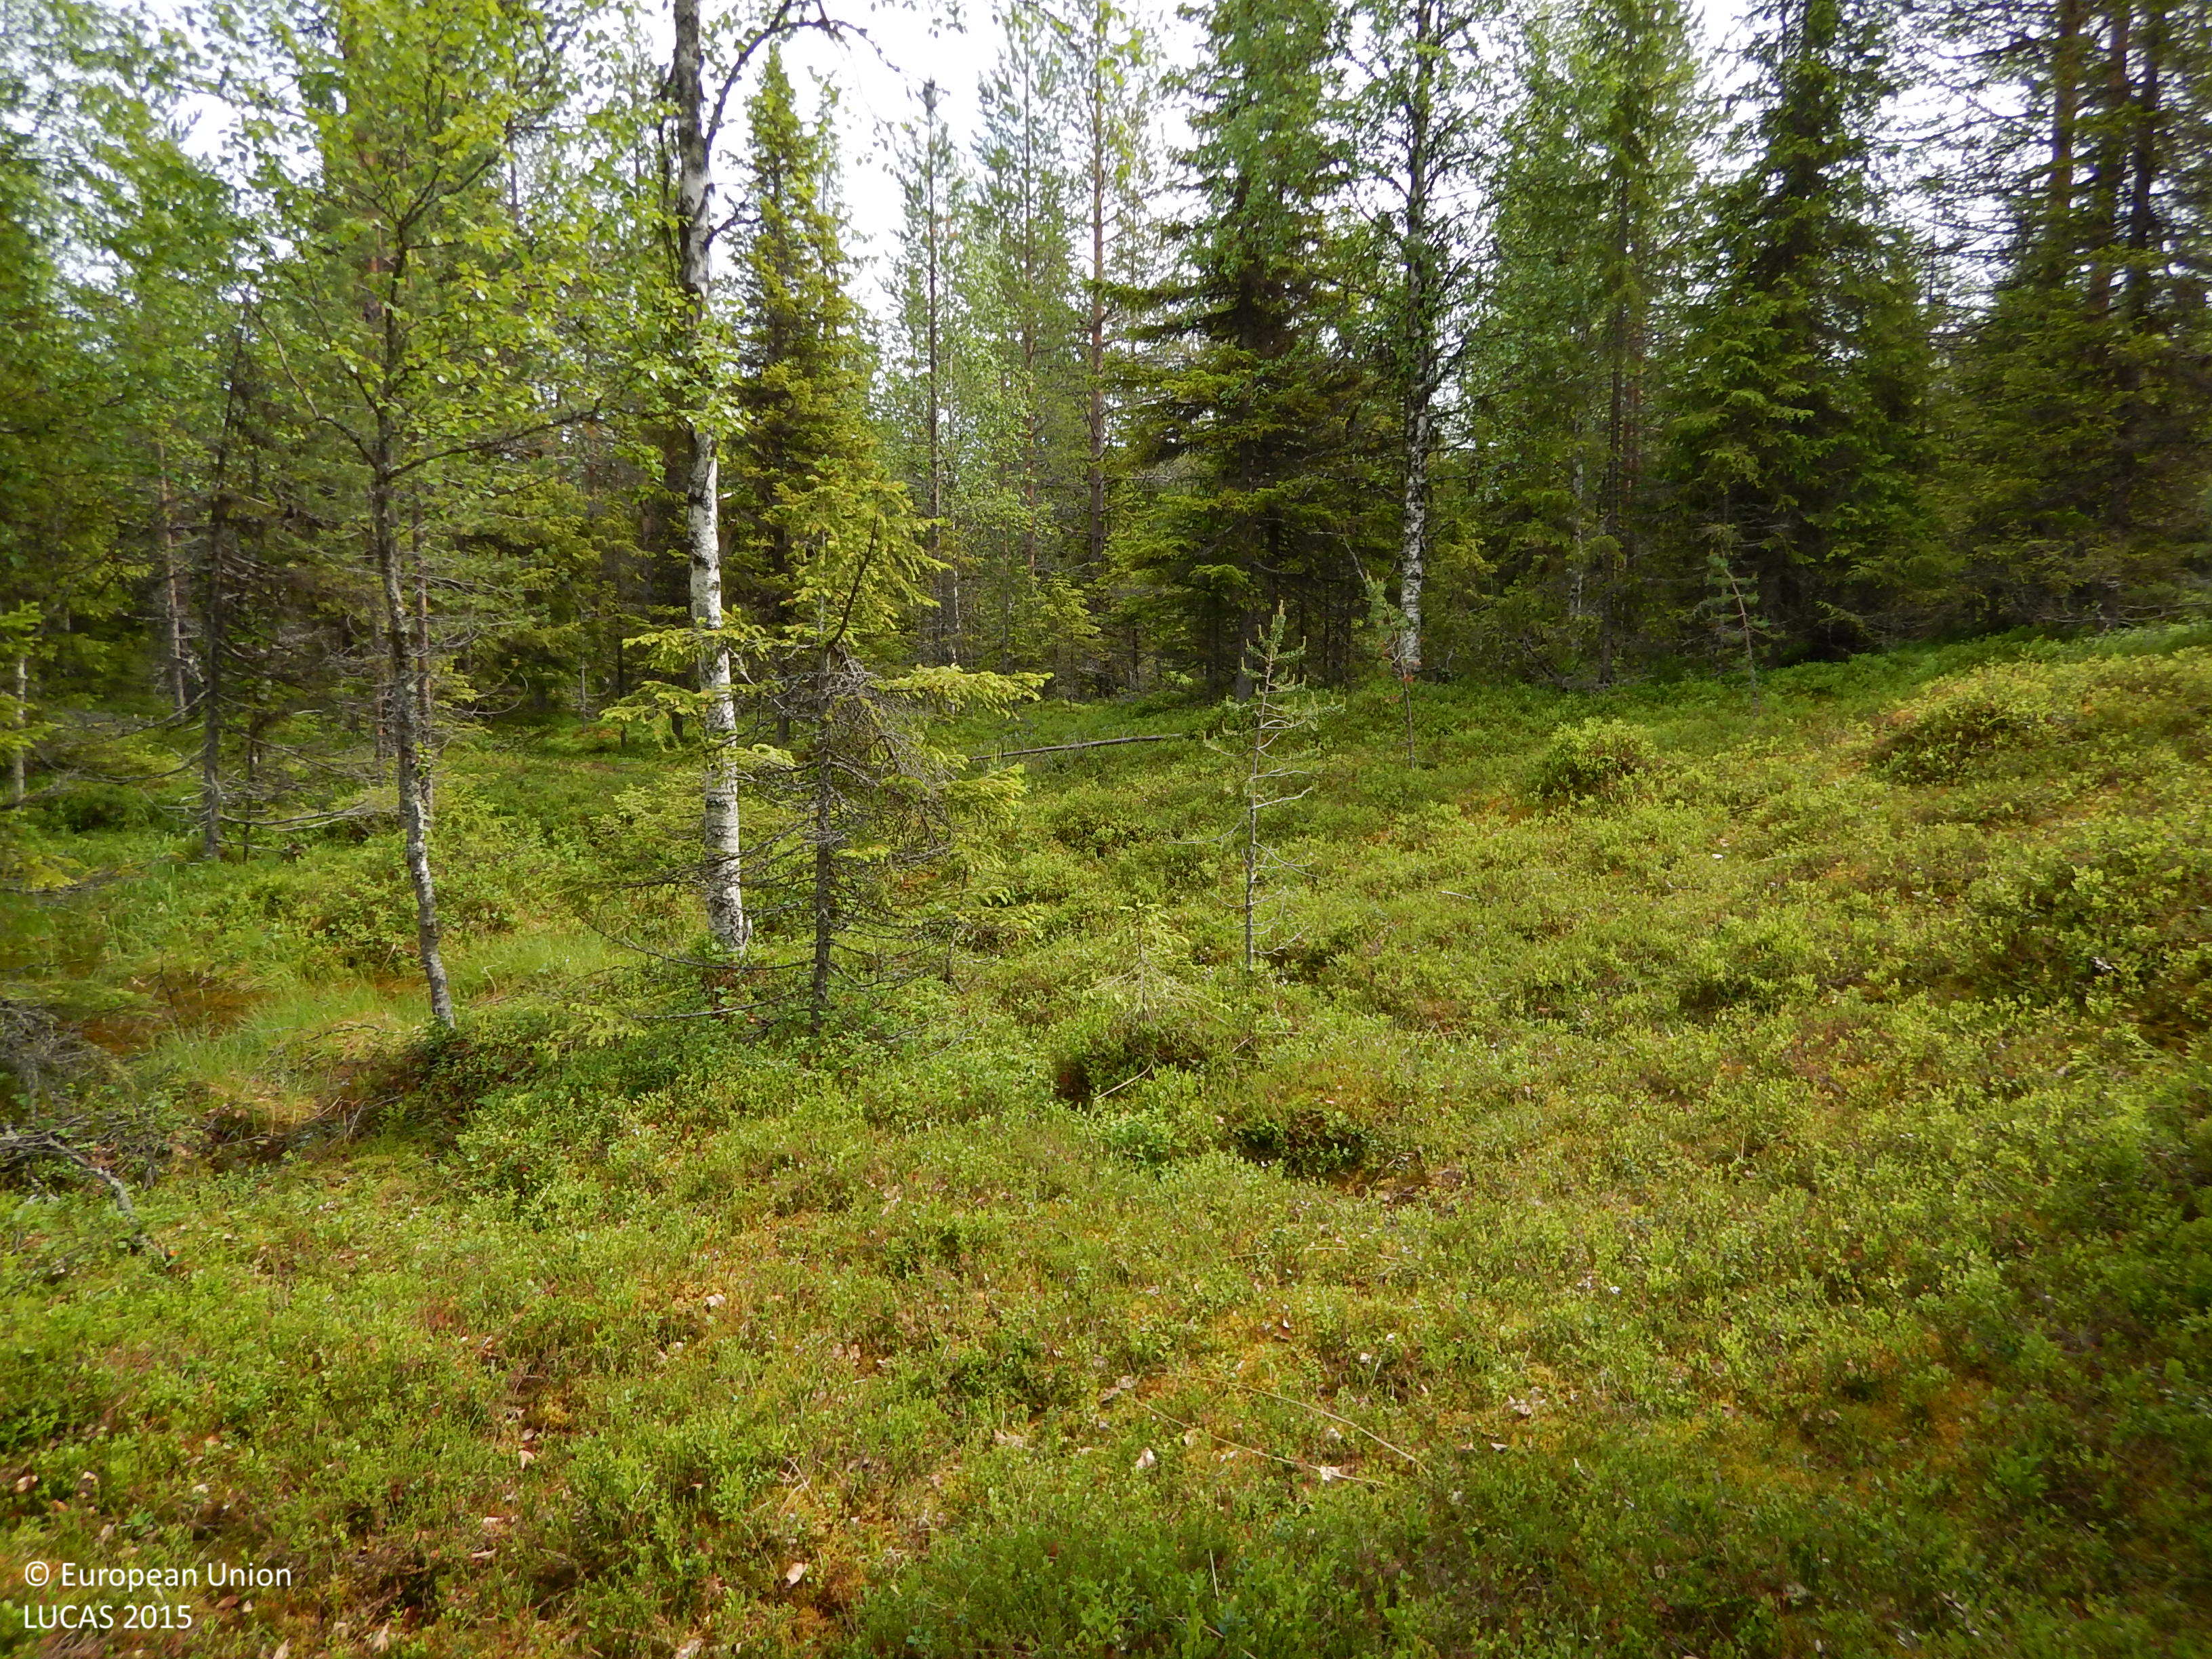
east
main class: Woodland
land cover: Spruce dominated coniferous woodland
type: boreal forest
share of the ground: 25 - 50 %
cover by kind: shrubs 40 %, coniferous forest trees 30 %, broadleaved forest trees 10 %, herbaceous plants 10 %, lichens and mosses 10 %
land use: Forestry
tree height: > 5 m
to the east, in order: Spruce dominated coniferous woodland; Paved roads, cycling and walking lanes; Spruce dominated mixed woodland; Tracks; Spruce dominated mixed woodland; Tracks; Spruce dominated mixed woodland; Spontaneously vegetated surfaces
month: July
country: SE
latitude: 65.2361
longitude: 18.9708
